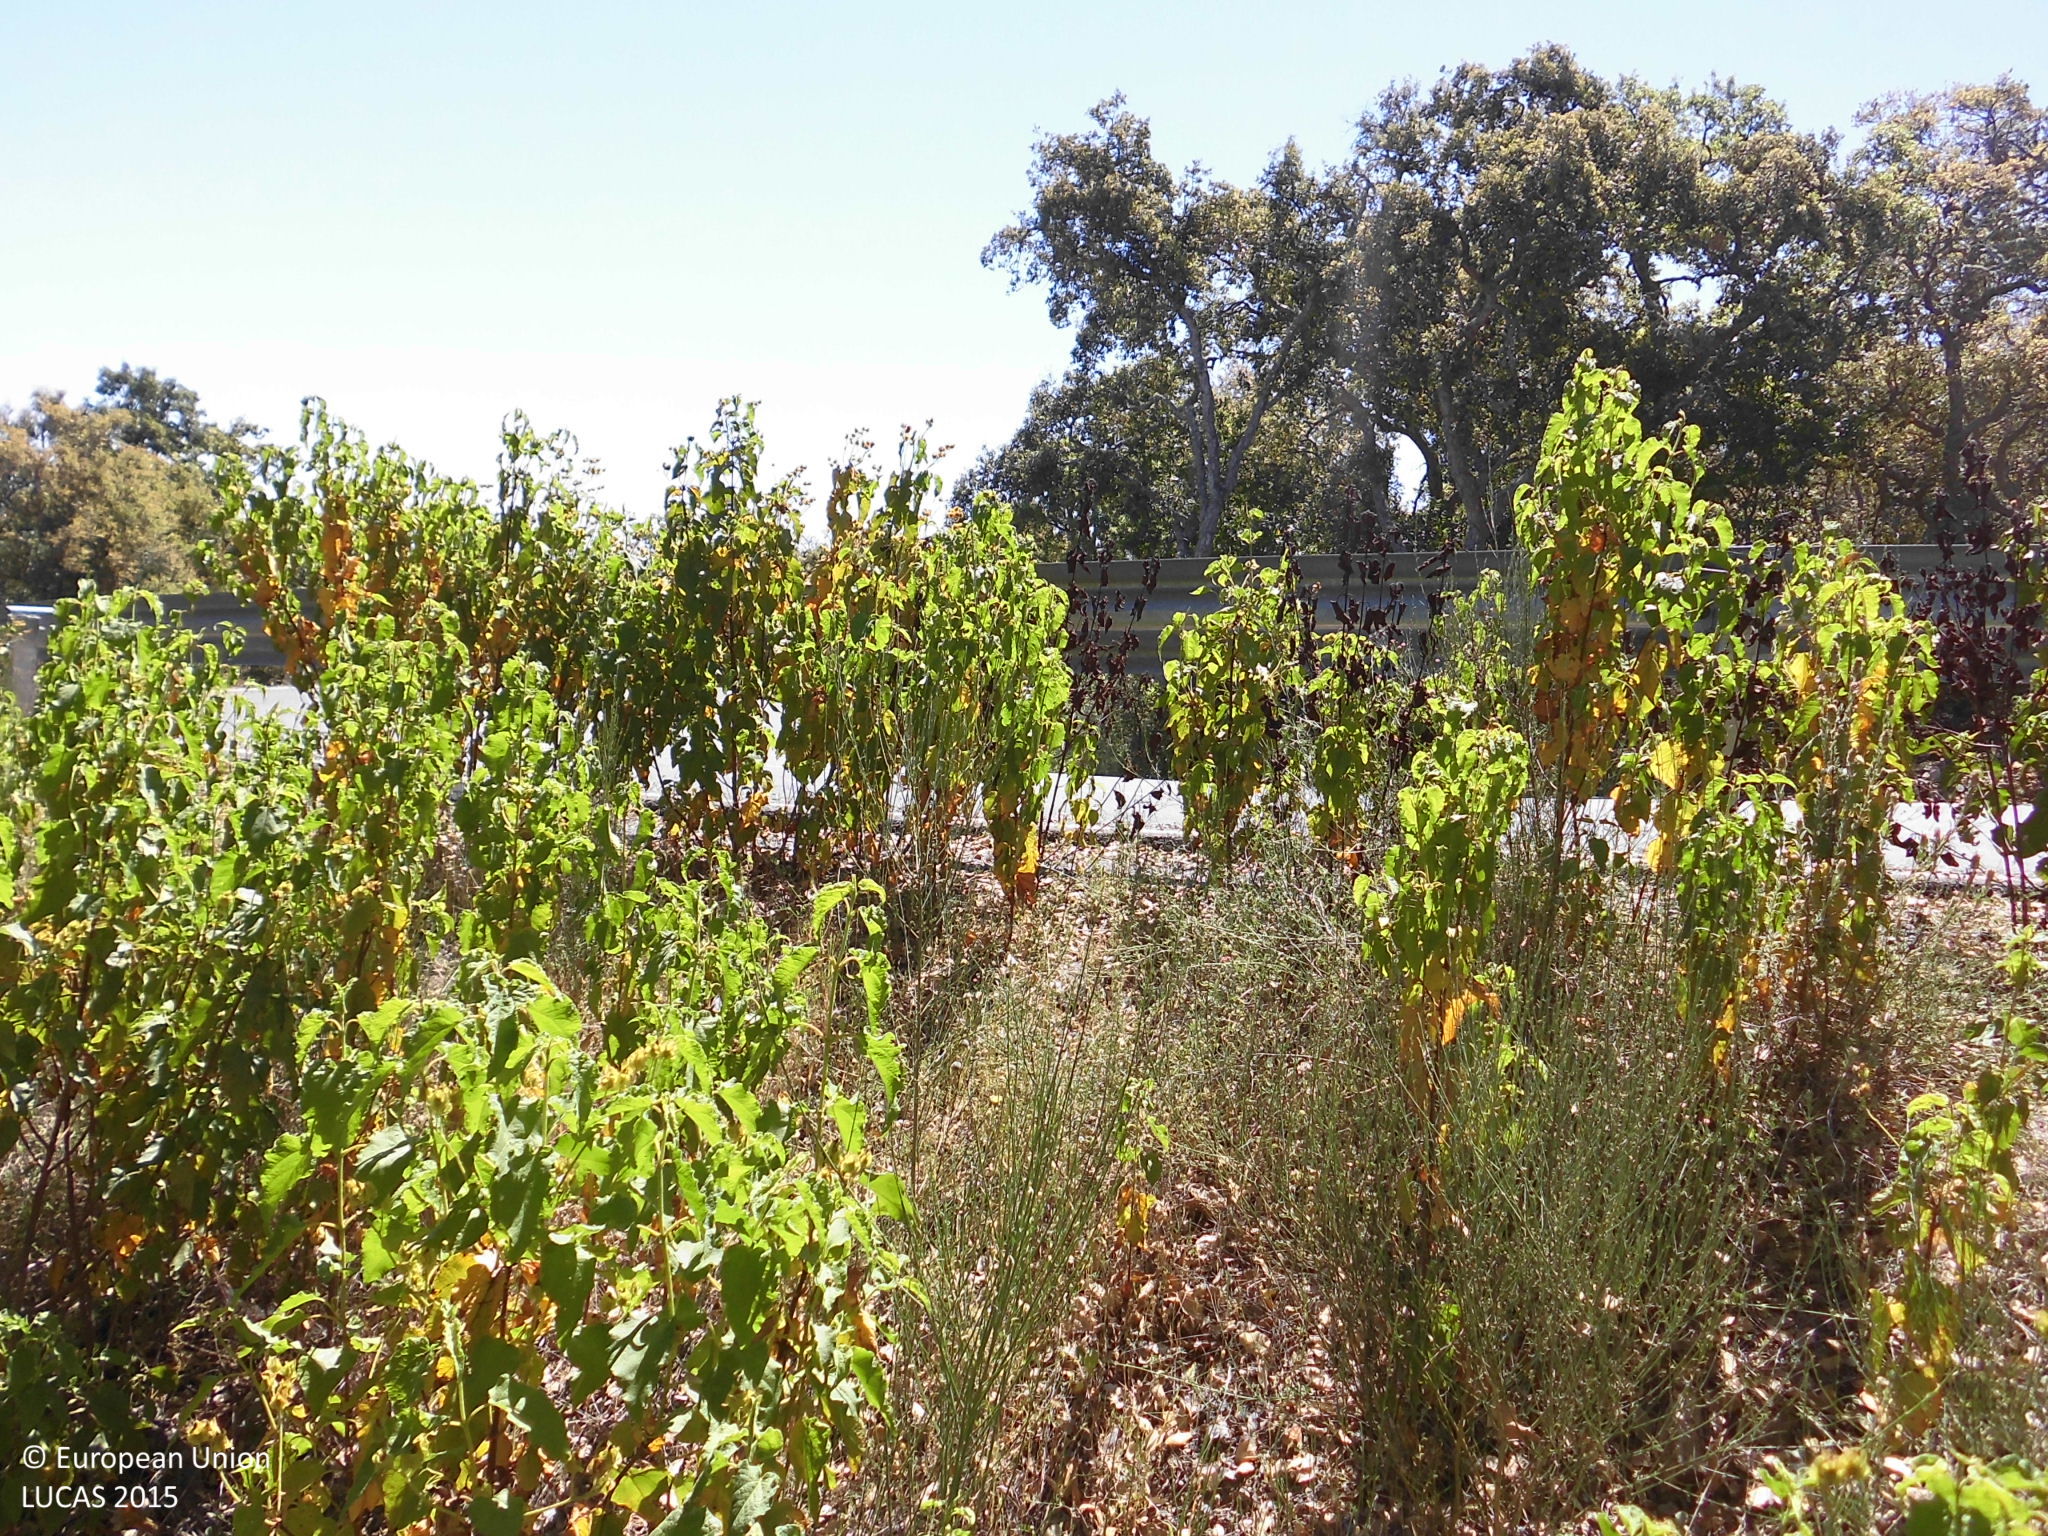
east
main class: Woodland
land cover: Broadleaved woodland
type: broadleaved evergreen forest
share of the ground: > 75 %
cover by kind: broadleaved forest trees 75 %, shrubs 25 %
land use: Forestry
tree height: > 5 m
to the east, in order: Broadleaved woodland
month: May
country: ES
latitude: 39.4434
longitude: -7.0582
